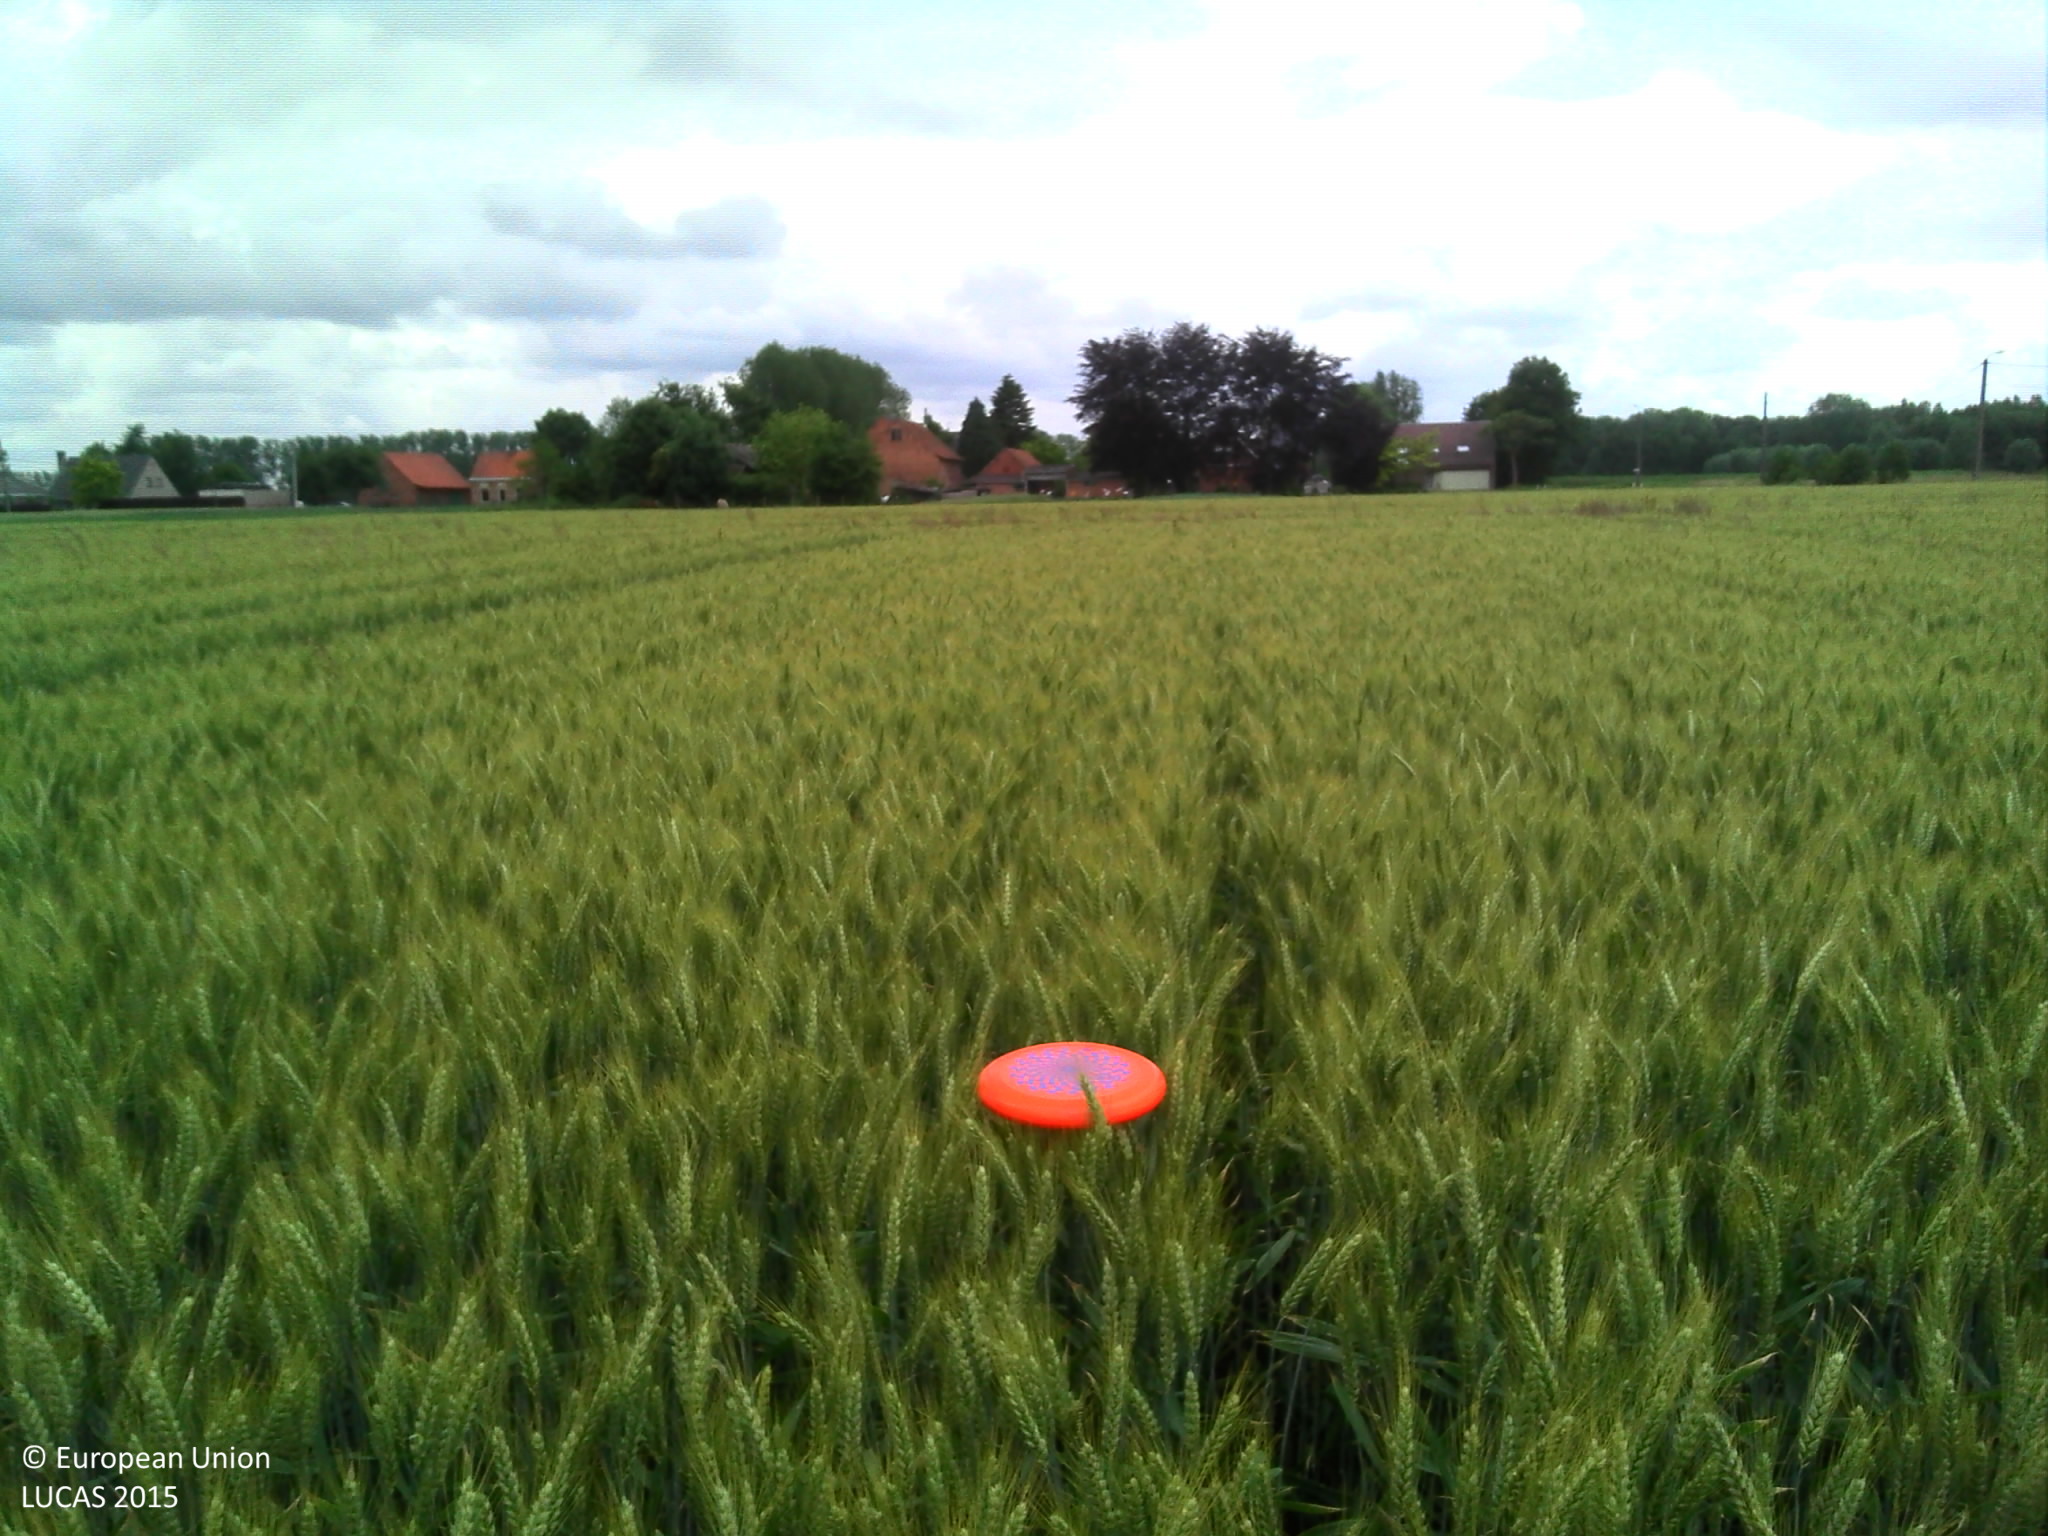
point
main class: Cropland
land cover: Common wheat
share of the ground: > 75 %
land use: Agriculture (excluding fallow land and kitchen gardens)
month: June
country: BE
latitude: 51.1981
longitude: 3.9979
